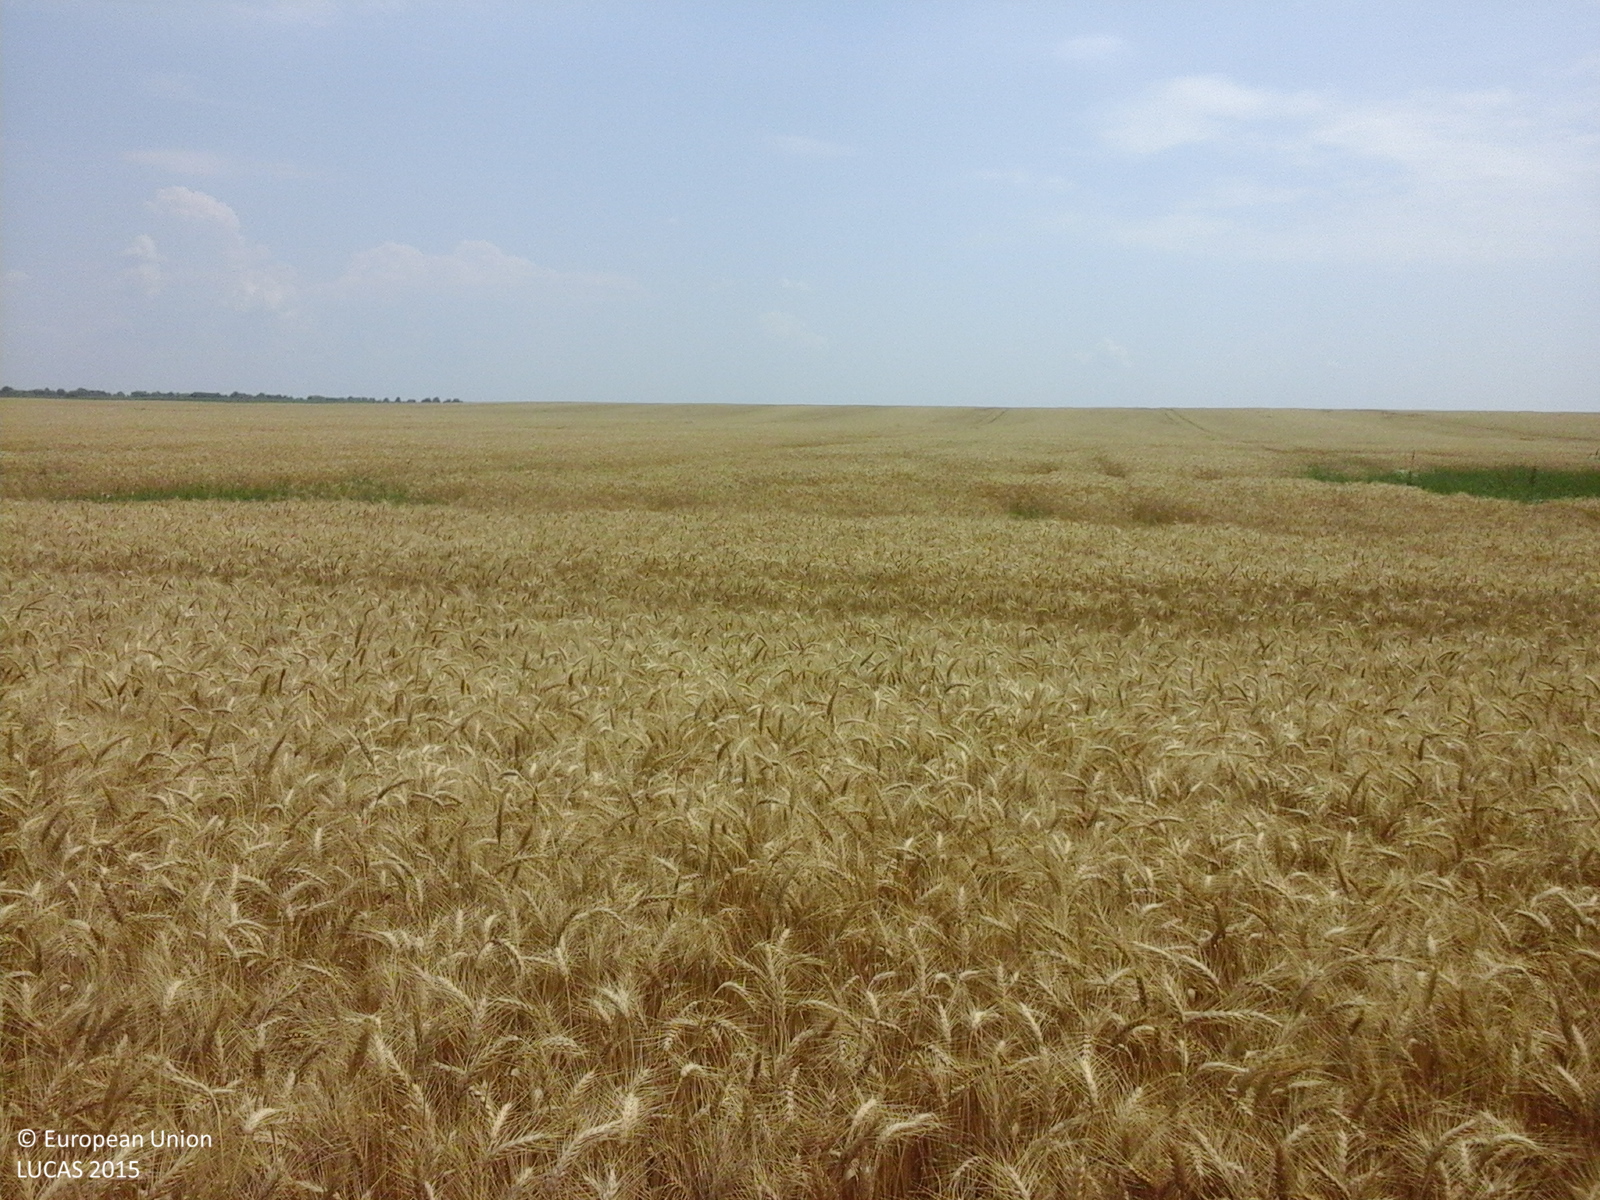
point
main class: Cropland
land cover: Common wheat
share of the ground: > 75 %
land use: Agriculture (excluding fallow land and kitchen gardens)
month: July
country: RO
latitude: 44.1788
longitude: 26.4855
